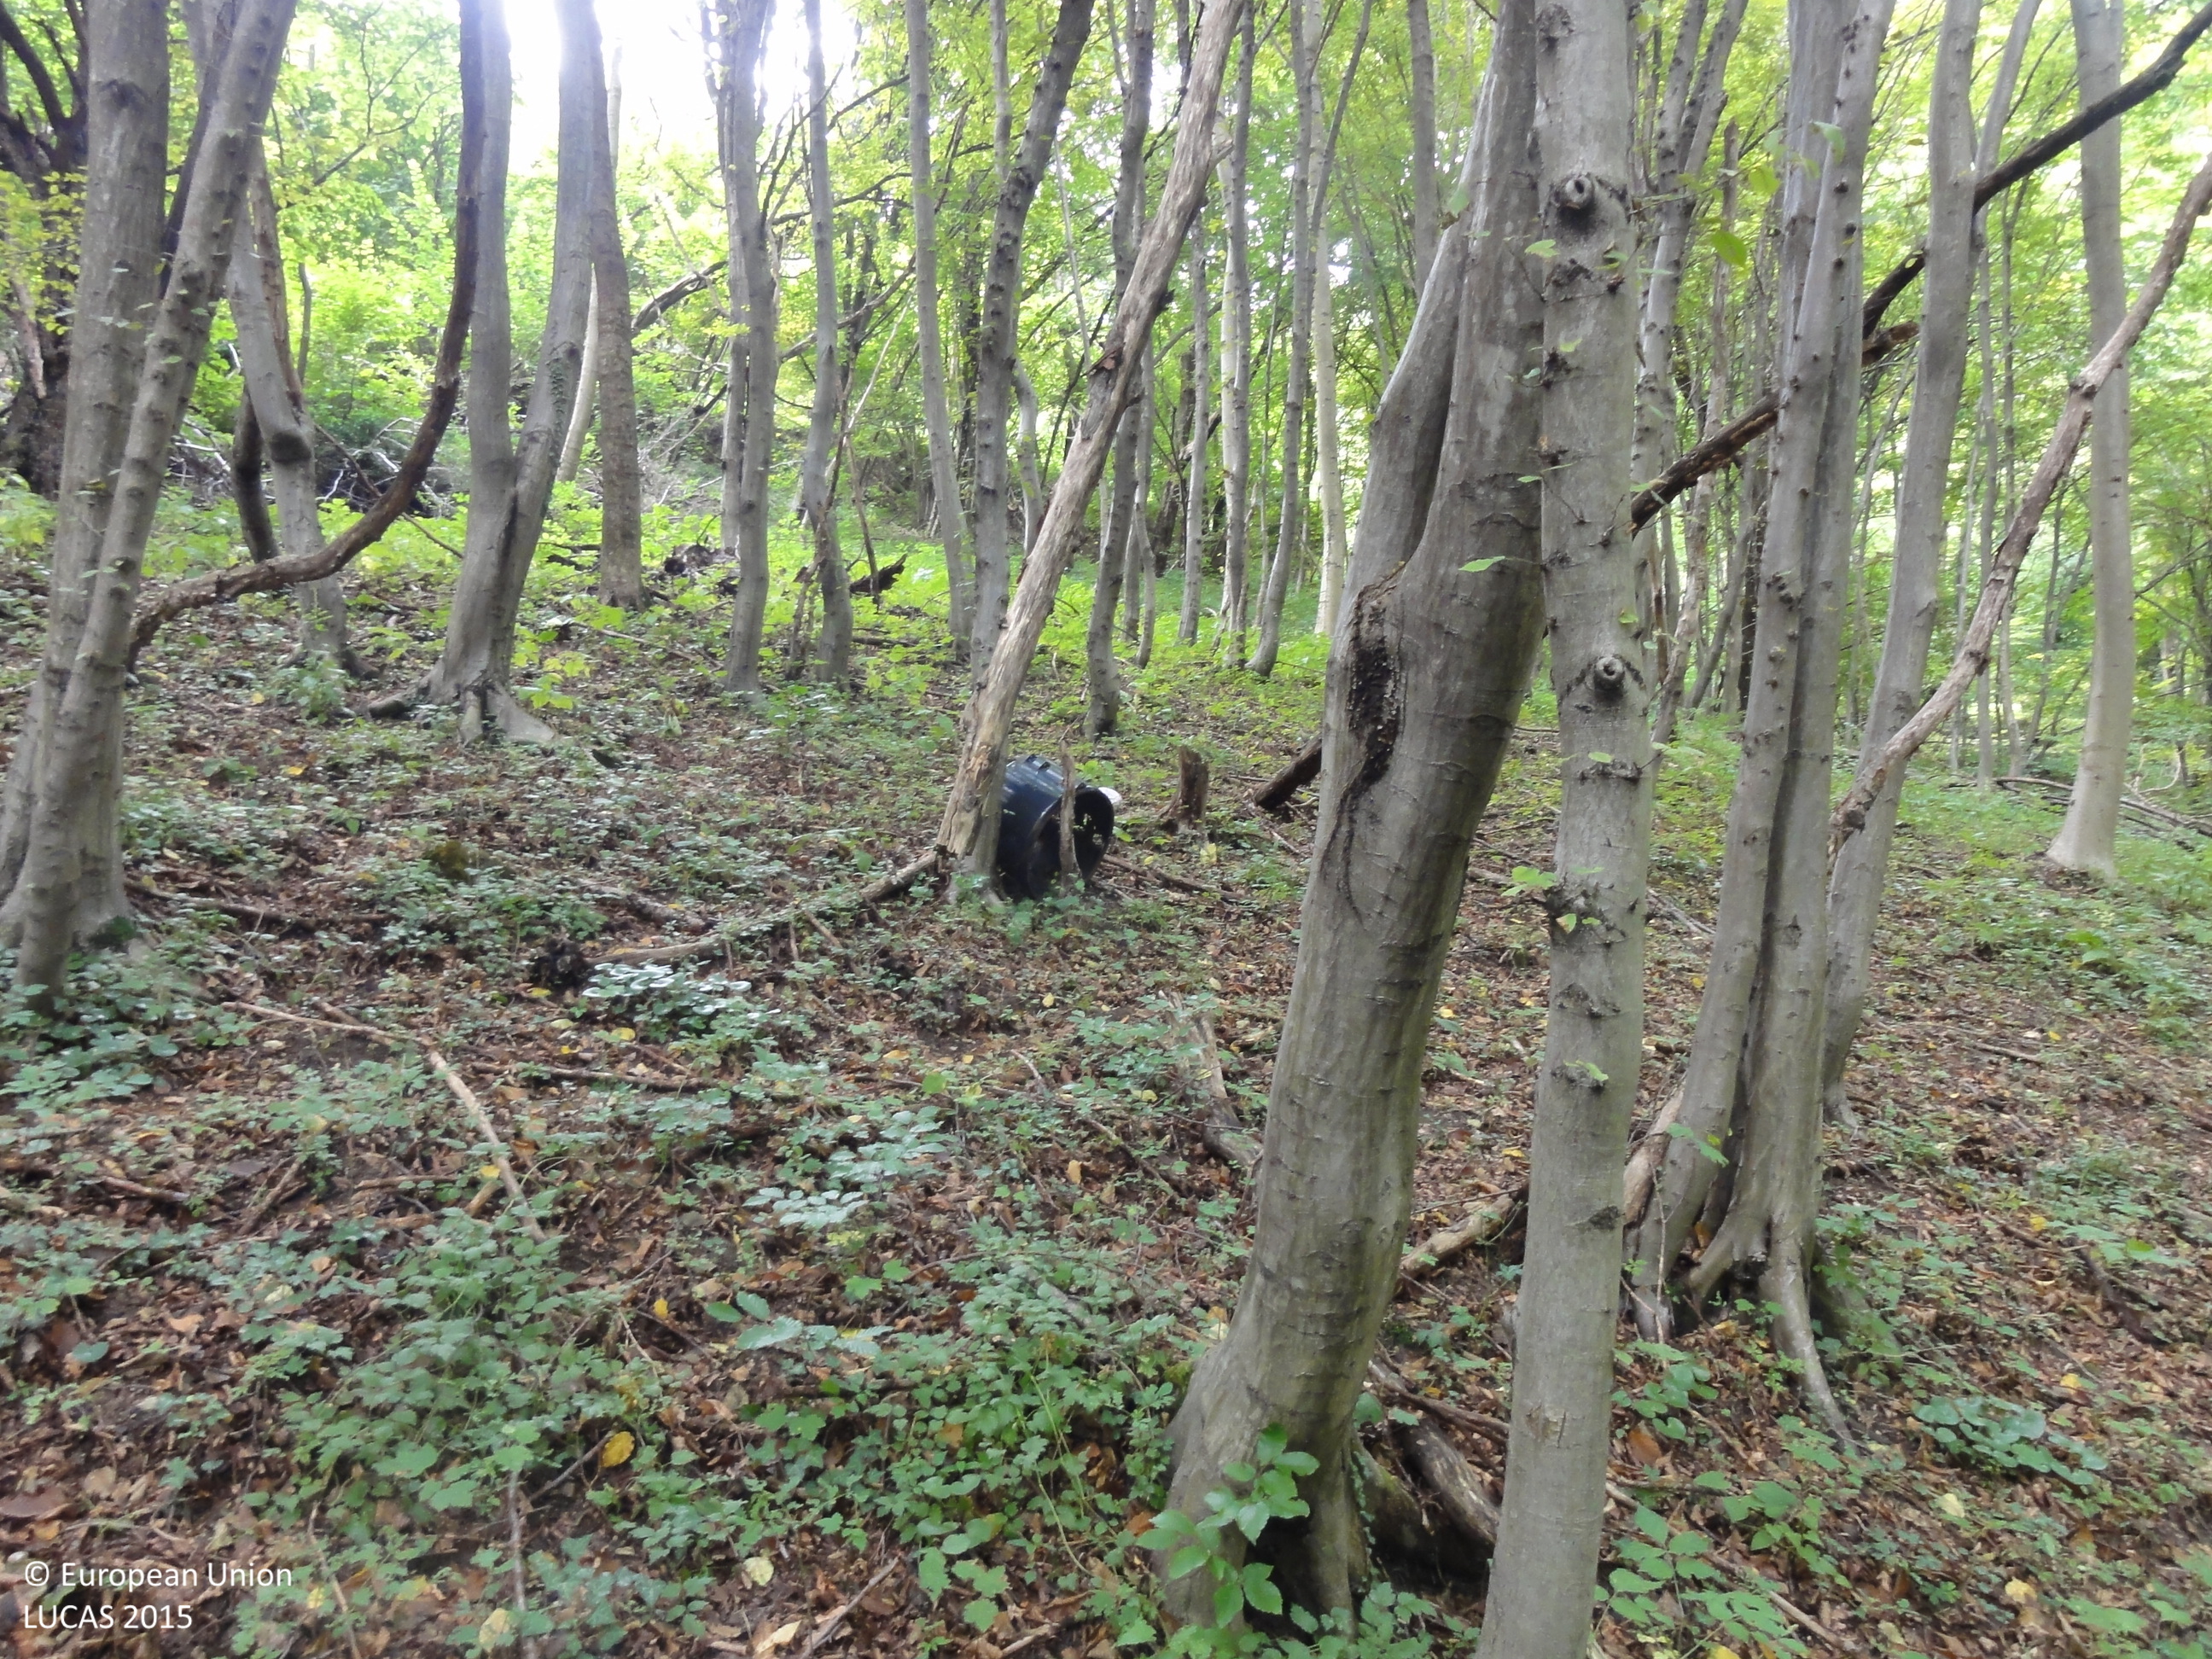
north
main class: Woodland
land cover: Broadleaved woodland
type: mesophytic deciduous forest
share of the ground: > 75 %
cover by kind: broadleaved forest trees 95 %, coniferous forest trees 5 %
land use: Forestry
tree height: > 5 m
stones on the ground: < 10 %
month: August
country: SI
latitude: 46.1605
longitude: 15.0347
